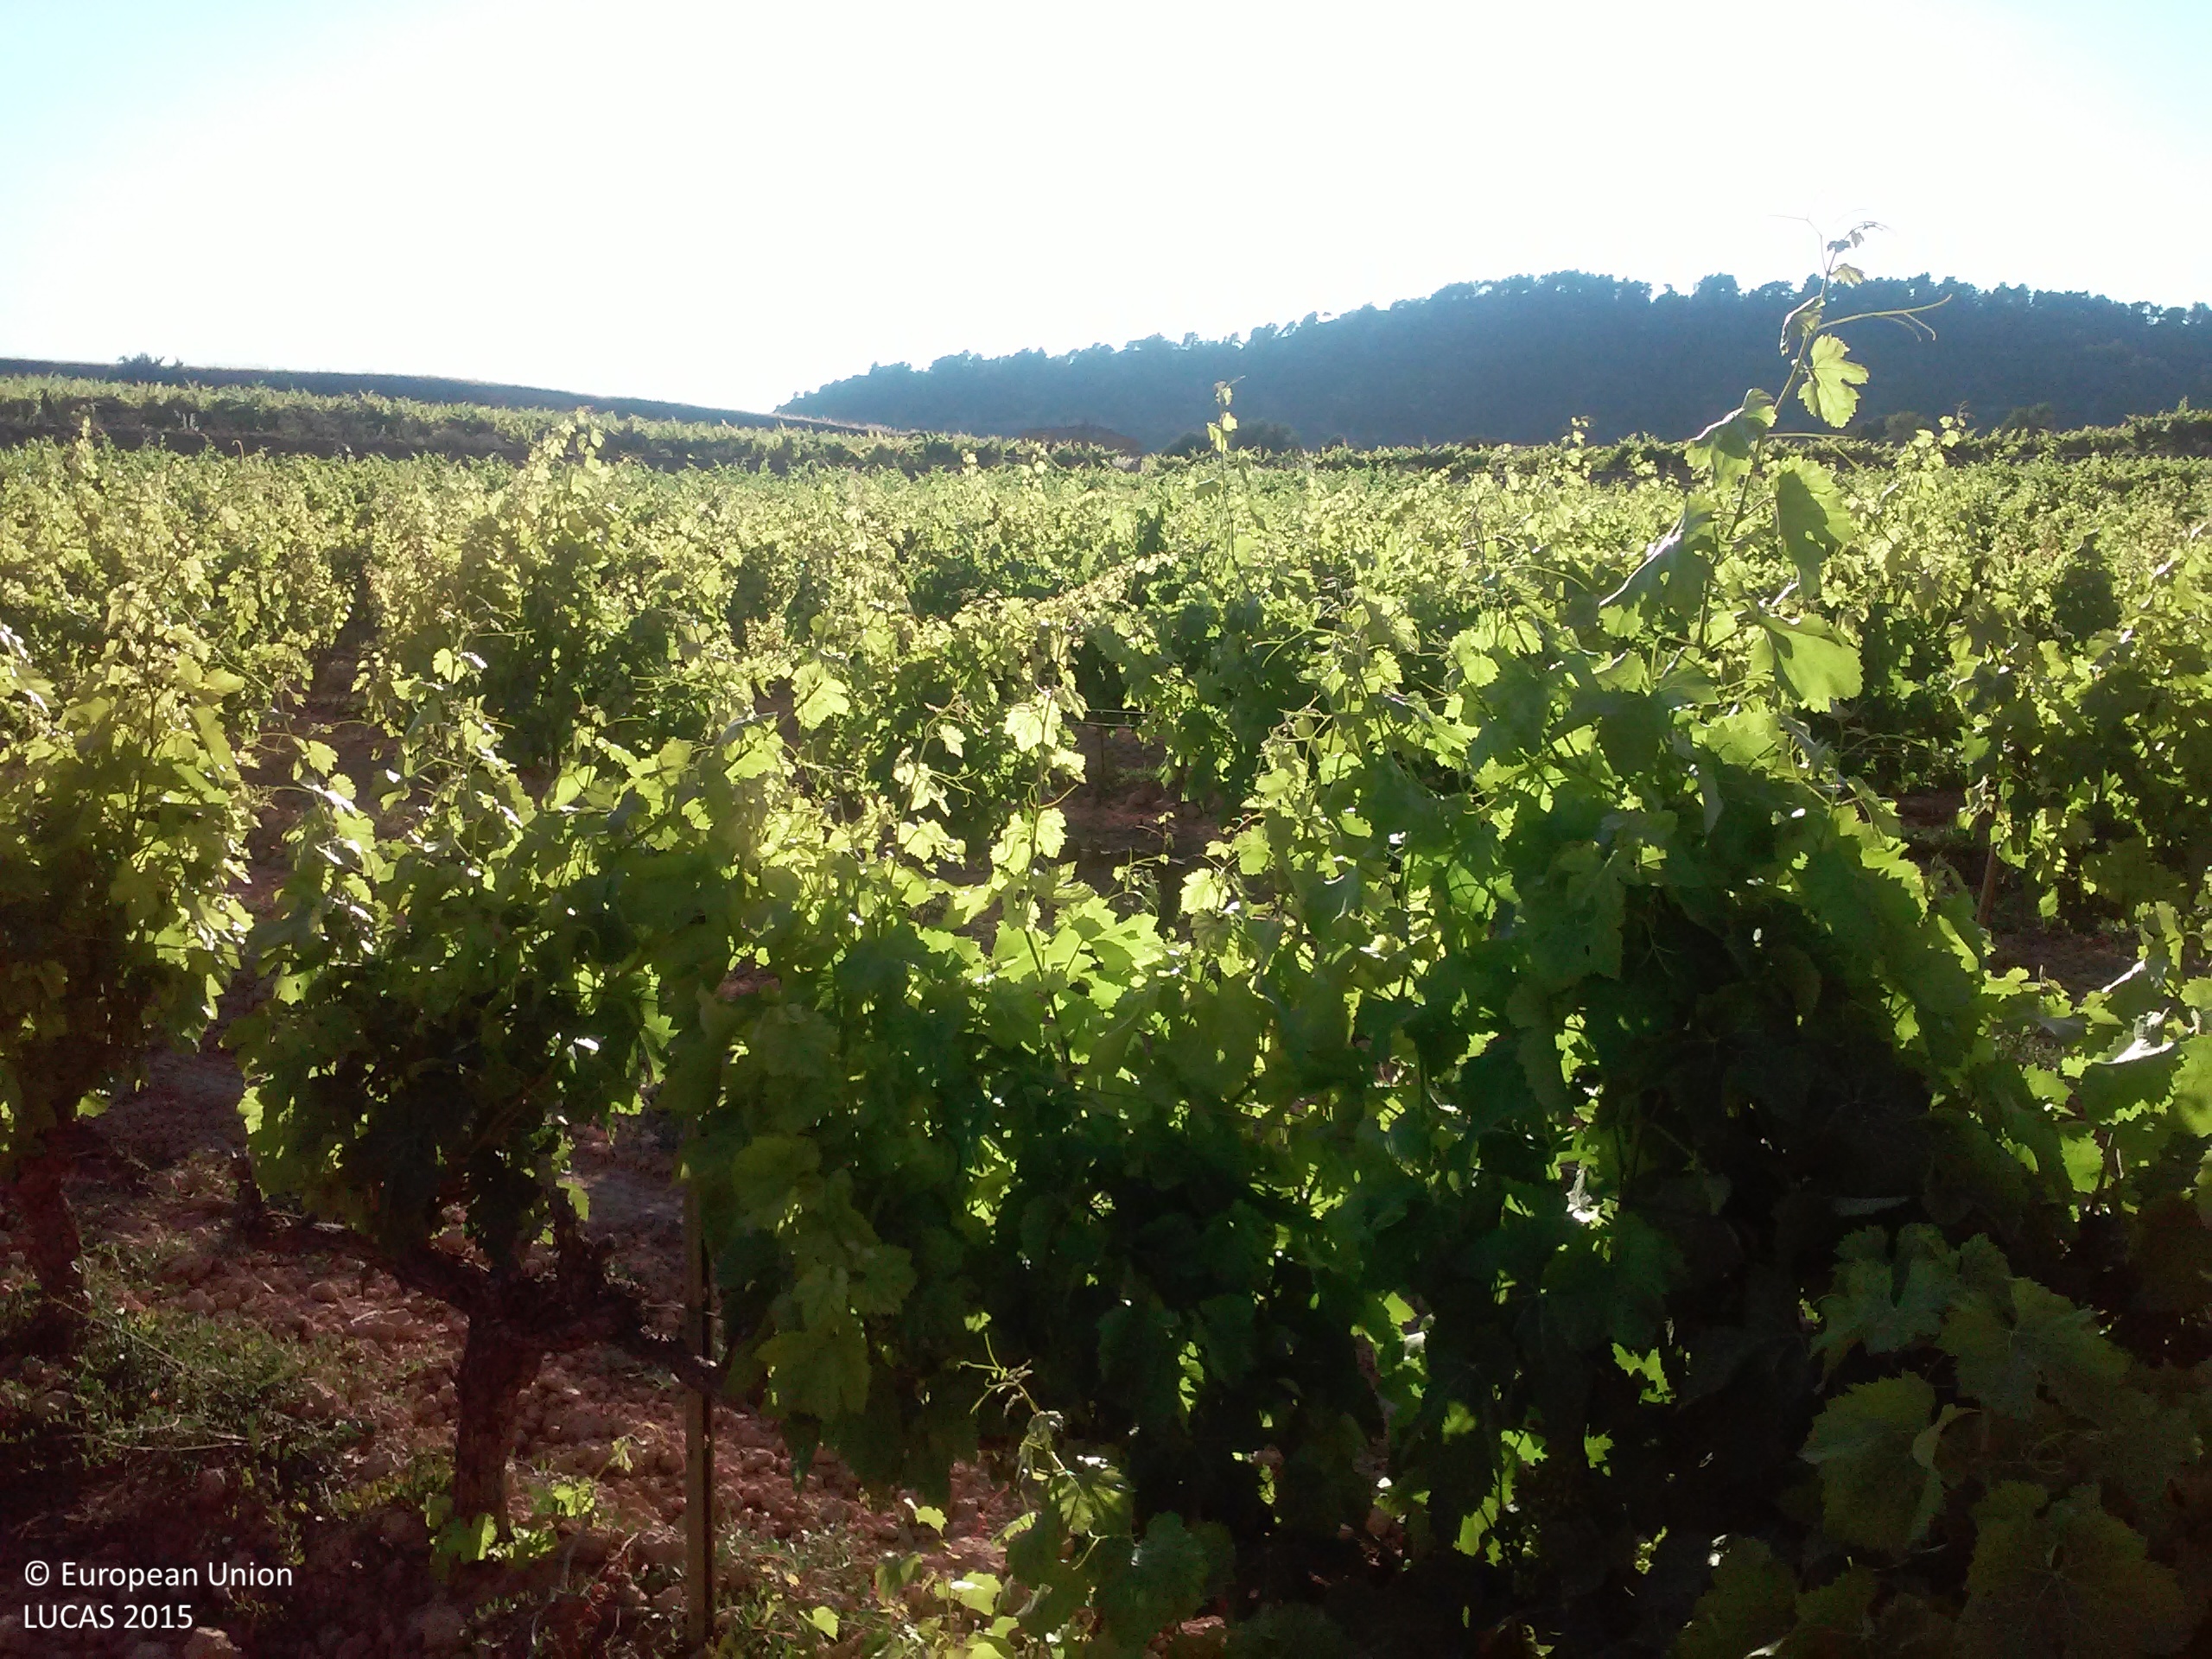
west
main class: Cropland
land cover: Vineyards
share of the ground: 10 - 25 %
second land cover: Other bare soil
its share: > 75 %
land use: Agriculture (excluding fallow land and kitchen gardens)
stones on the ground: 10 - 25 %
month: June
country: ES
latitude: 41.4524
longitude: 1.1927
